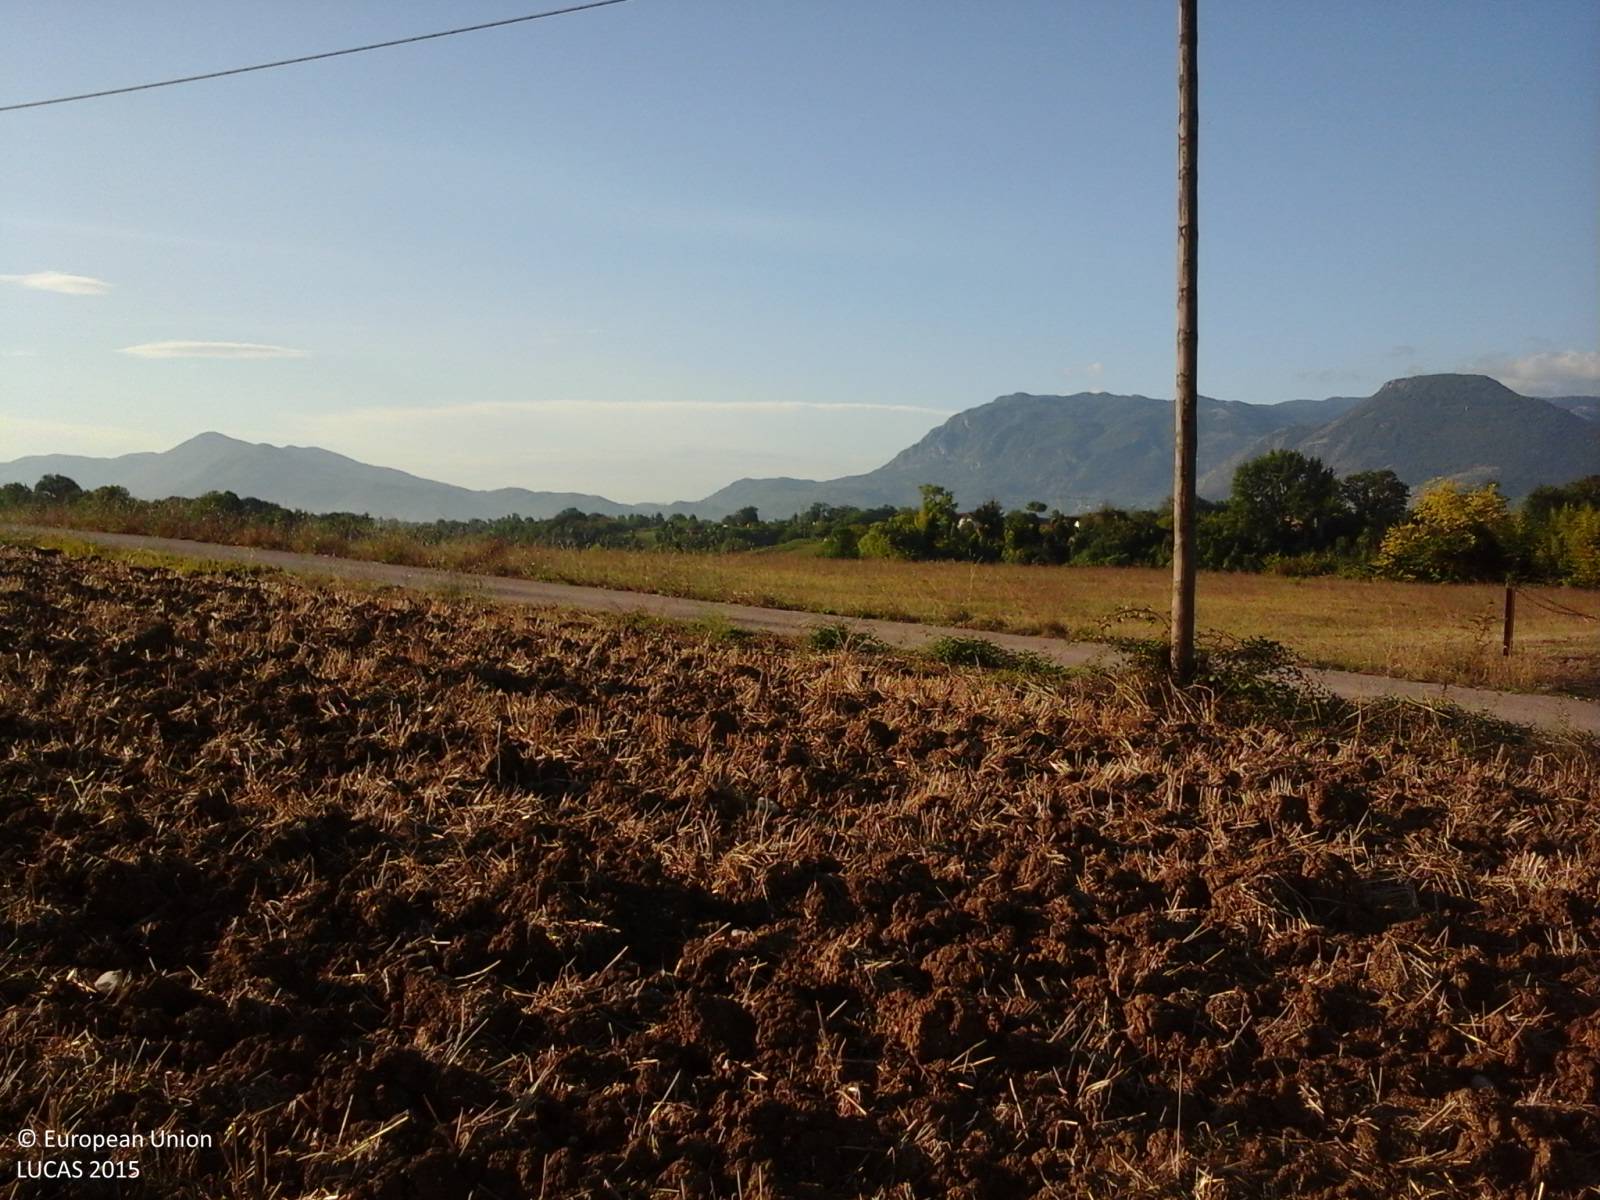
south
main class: Cropland
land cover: Common wheat
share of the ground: < 10 %
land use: Agriculture (excluding fallow land and kitchen gardens)
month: August
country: IT
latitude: 41.4656
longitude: 13.6856
